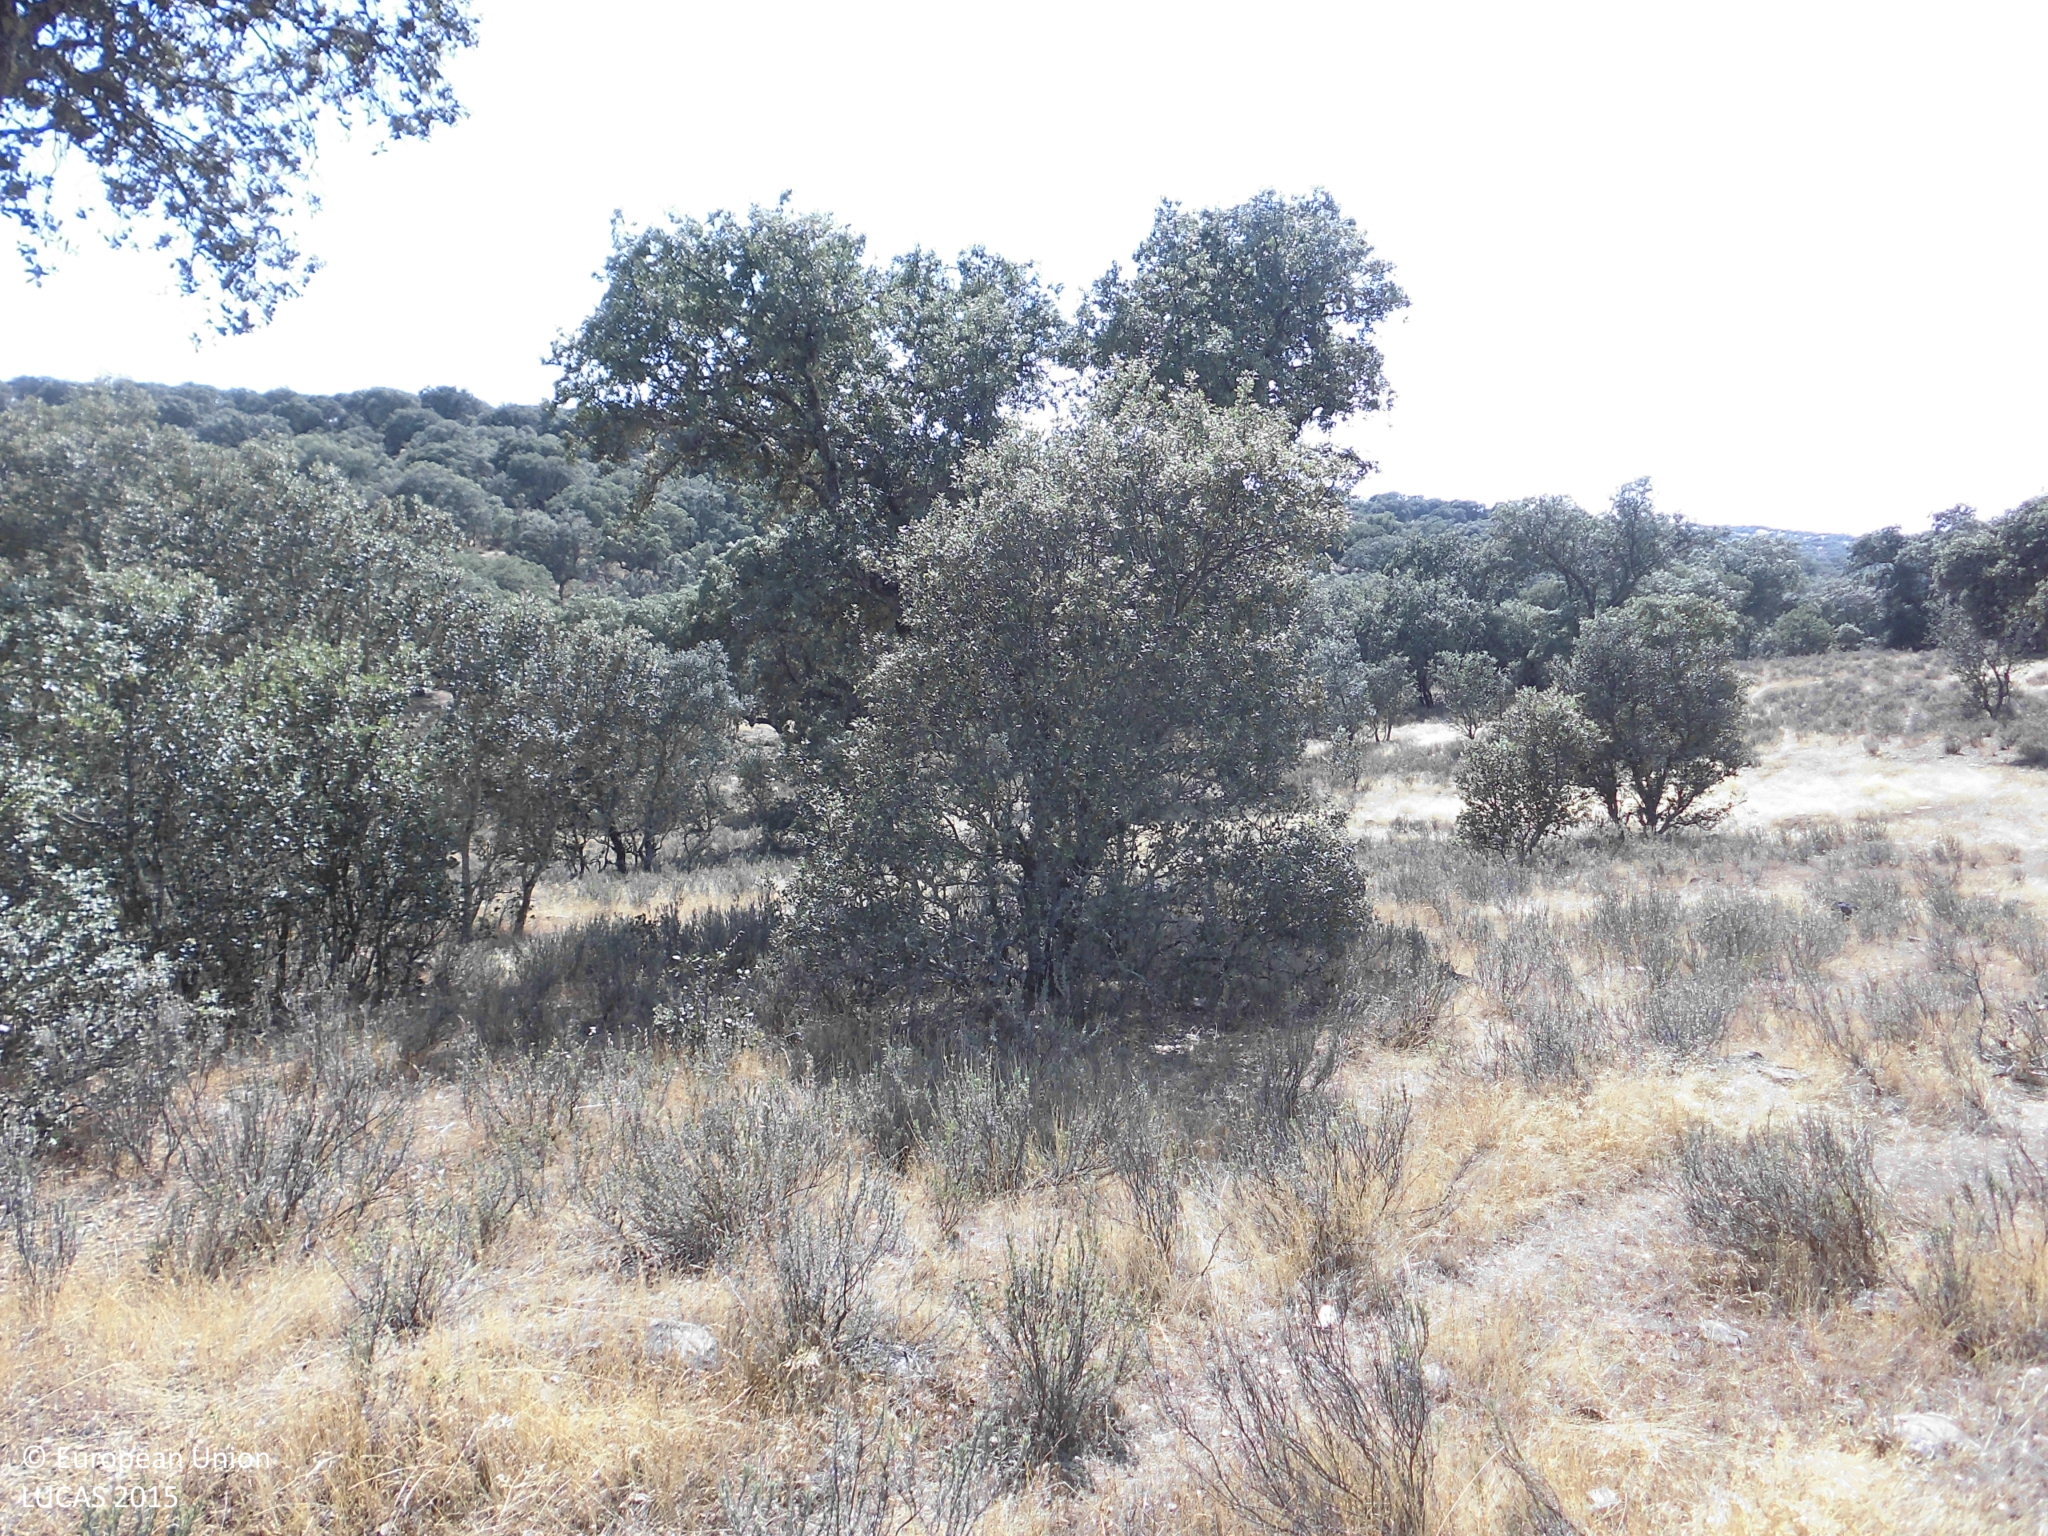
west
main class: Woodland
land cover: Broadleaved woodland
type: broadleaved evergreen forest
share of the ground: 10 - 25 %
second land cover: Grassland without tree/shrub cover
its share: > 75 %
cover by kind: herbaceous plants 65 %, shrubs 20 %, broadleaved forest trees 15 %
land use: Forestry
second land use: Agriculture (excluding fallow land and kitchen gardens)
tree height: > 5 m
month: June
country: ES
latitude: 39.7573
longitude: -6.0929
